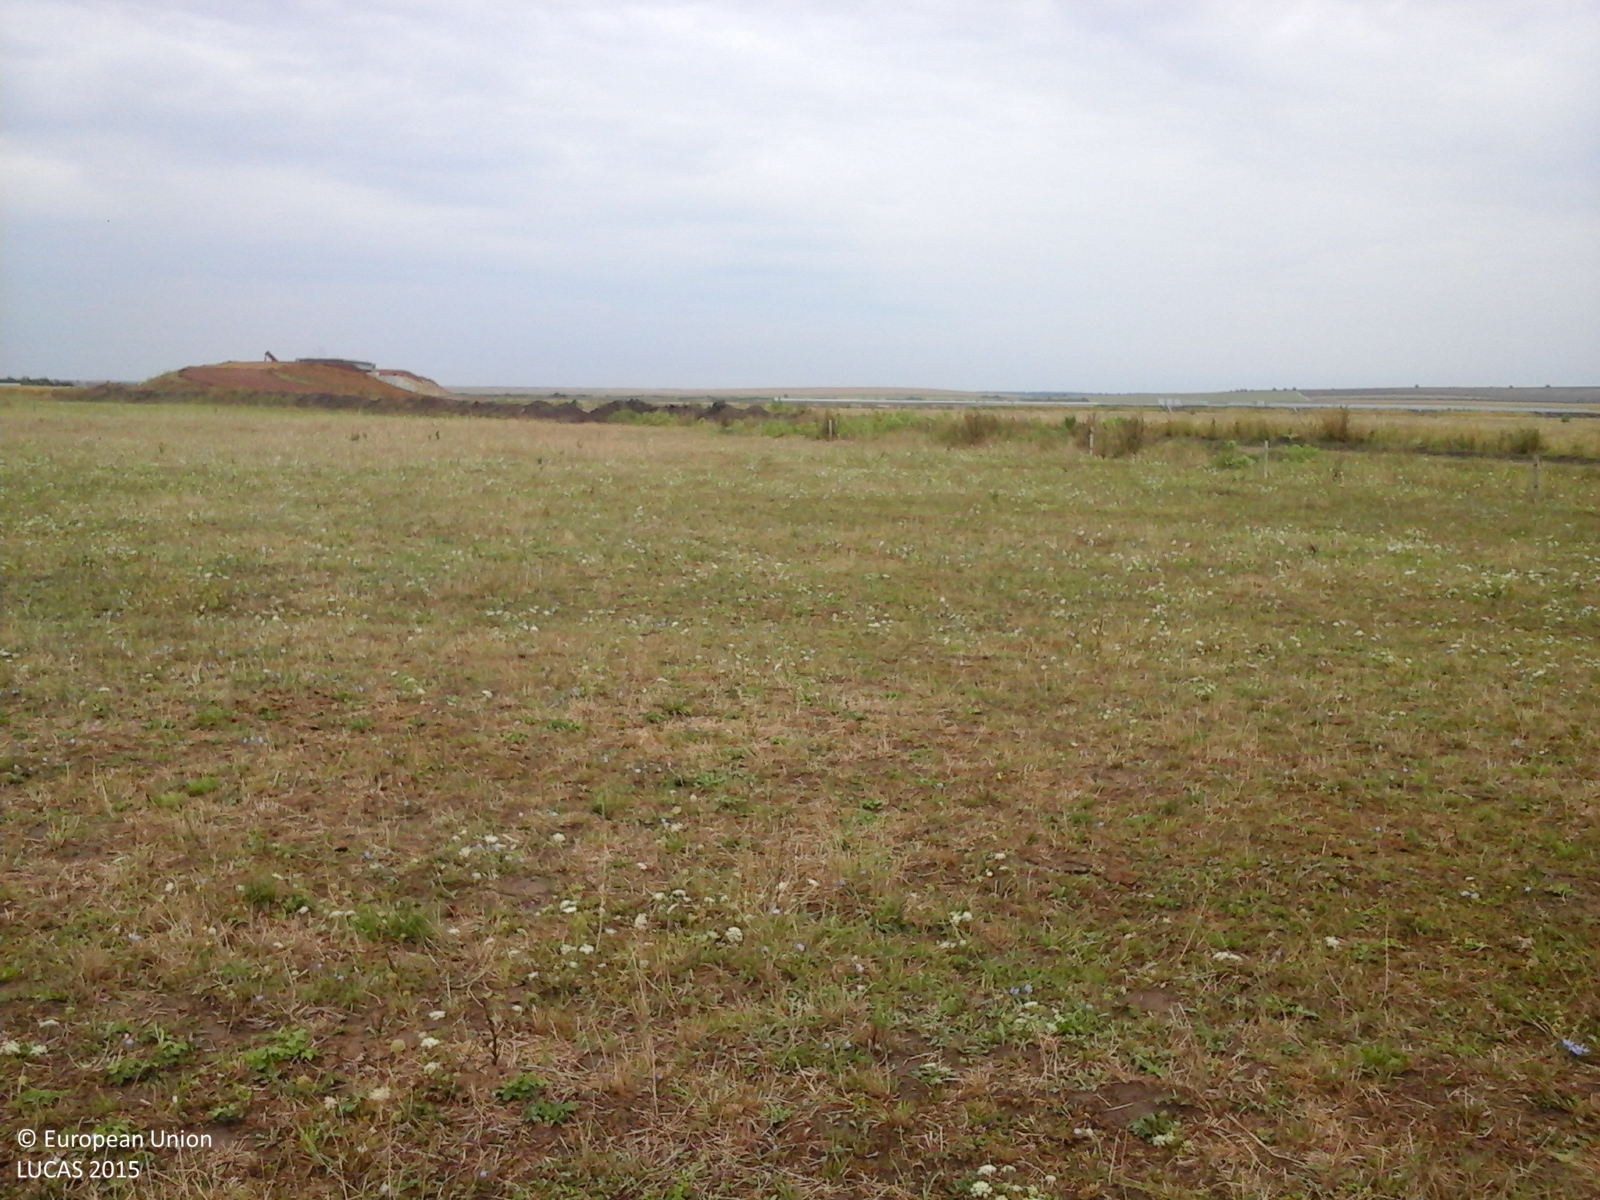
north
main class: Grassland
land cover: Grassland without tree/shrub cover
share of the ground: > 75 %
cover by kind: herbaceous plants 100 %
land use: Agriculture (excluding fallow land and kitchen gardens)
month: August
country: RO
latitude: 45.8072
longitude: 21.4472
